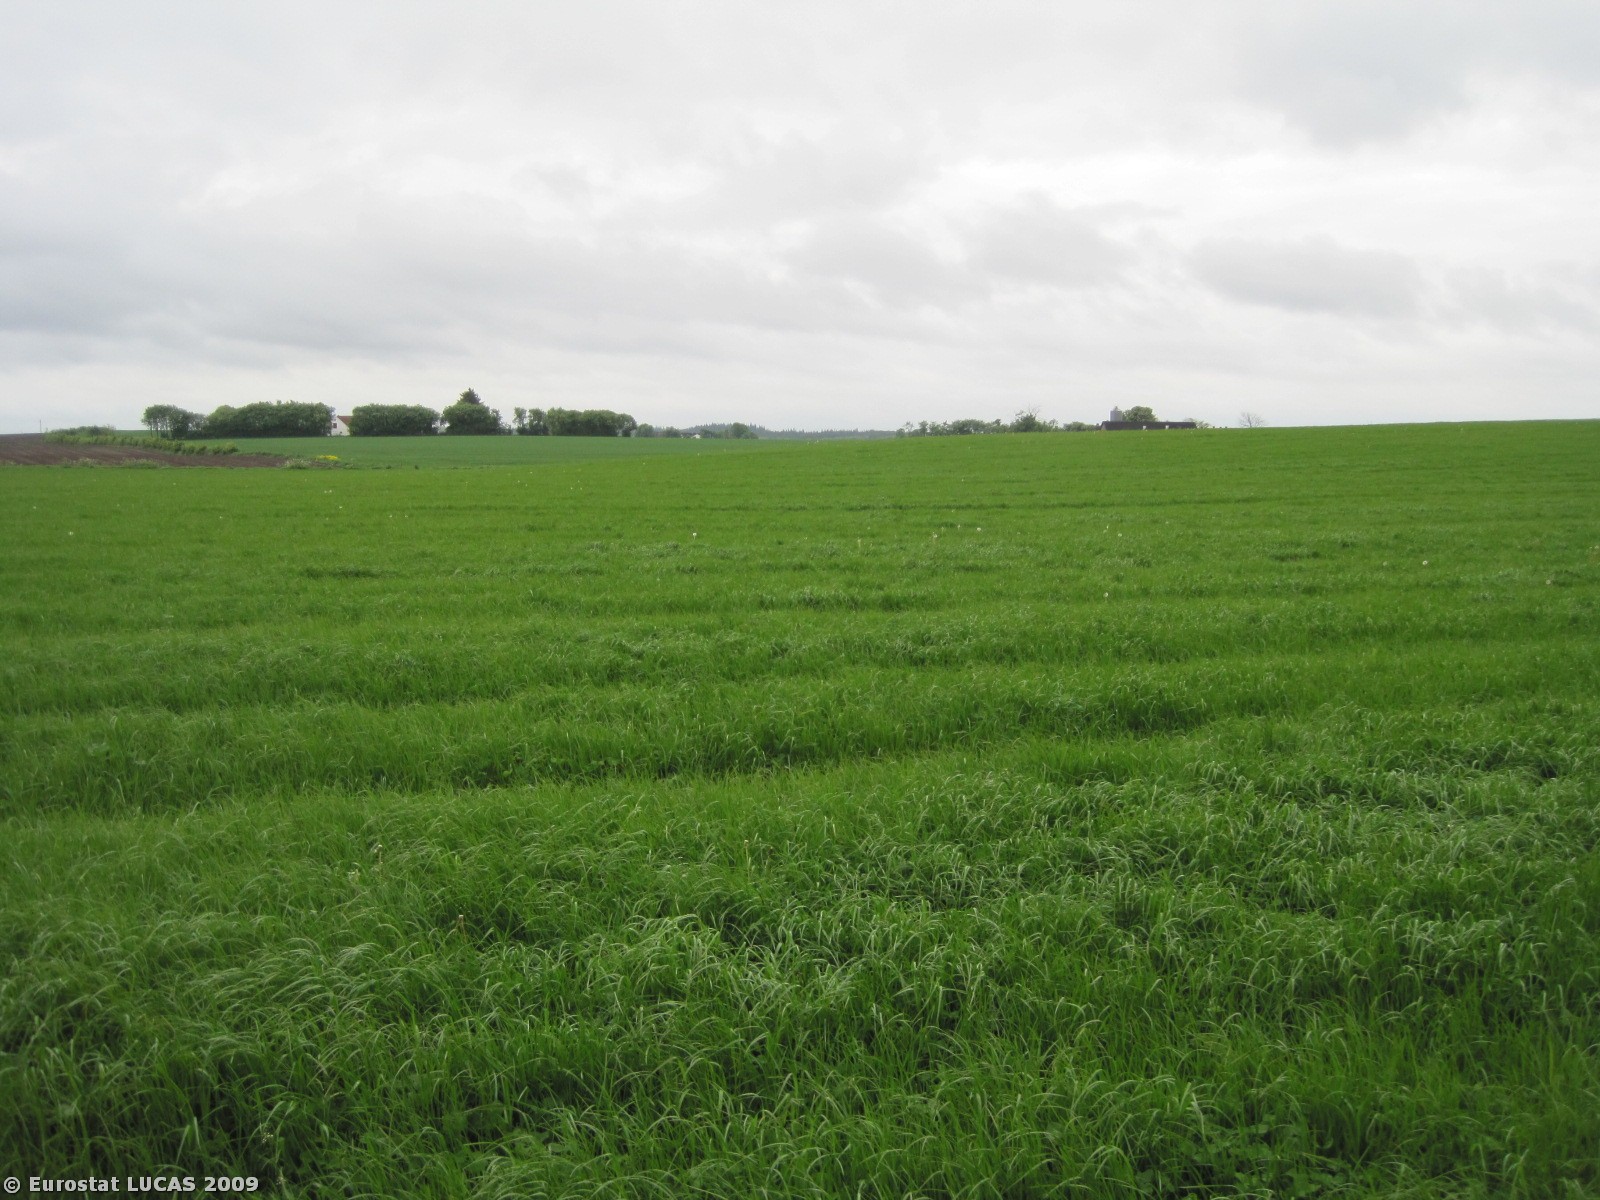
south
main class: Grassland
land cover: Grassland without tree/shrub cover
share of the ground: > 75 %
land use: Agriculture (excluding fallow land and kitchen gardens)
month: May
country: DK
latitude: 56.8347
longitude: 9.7545
